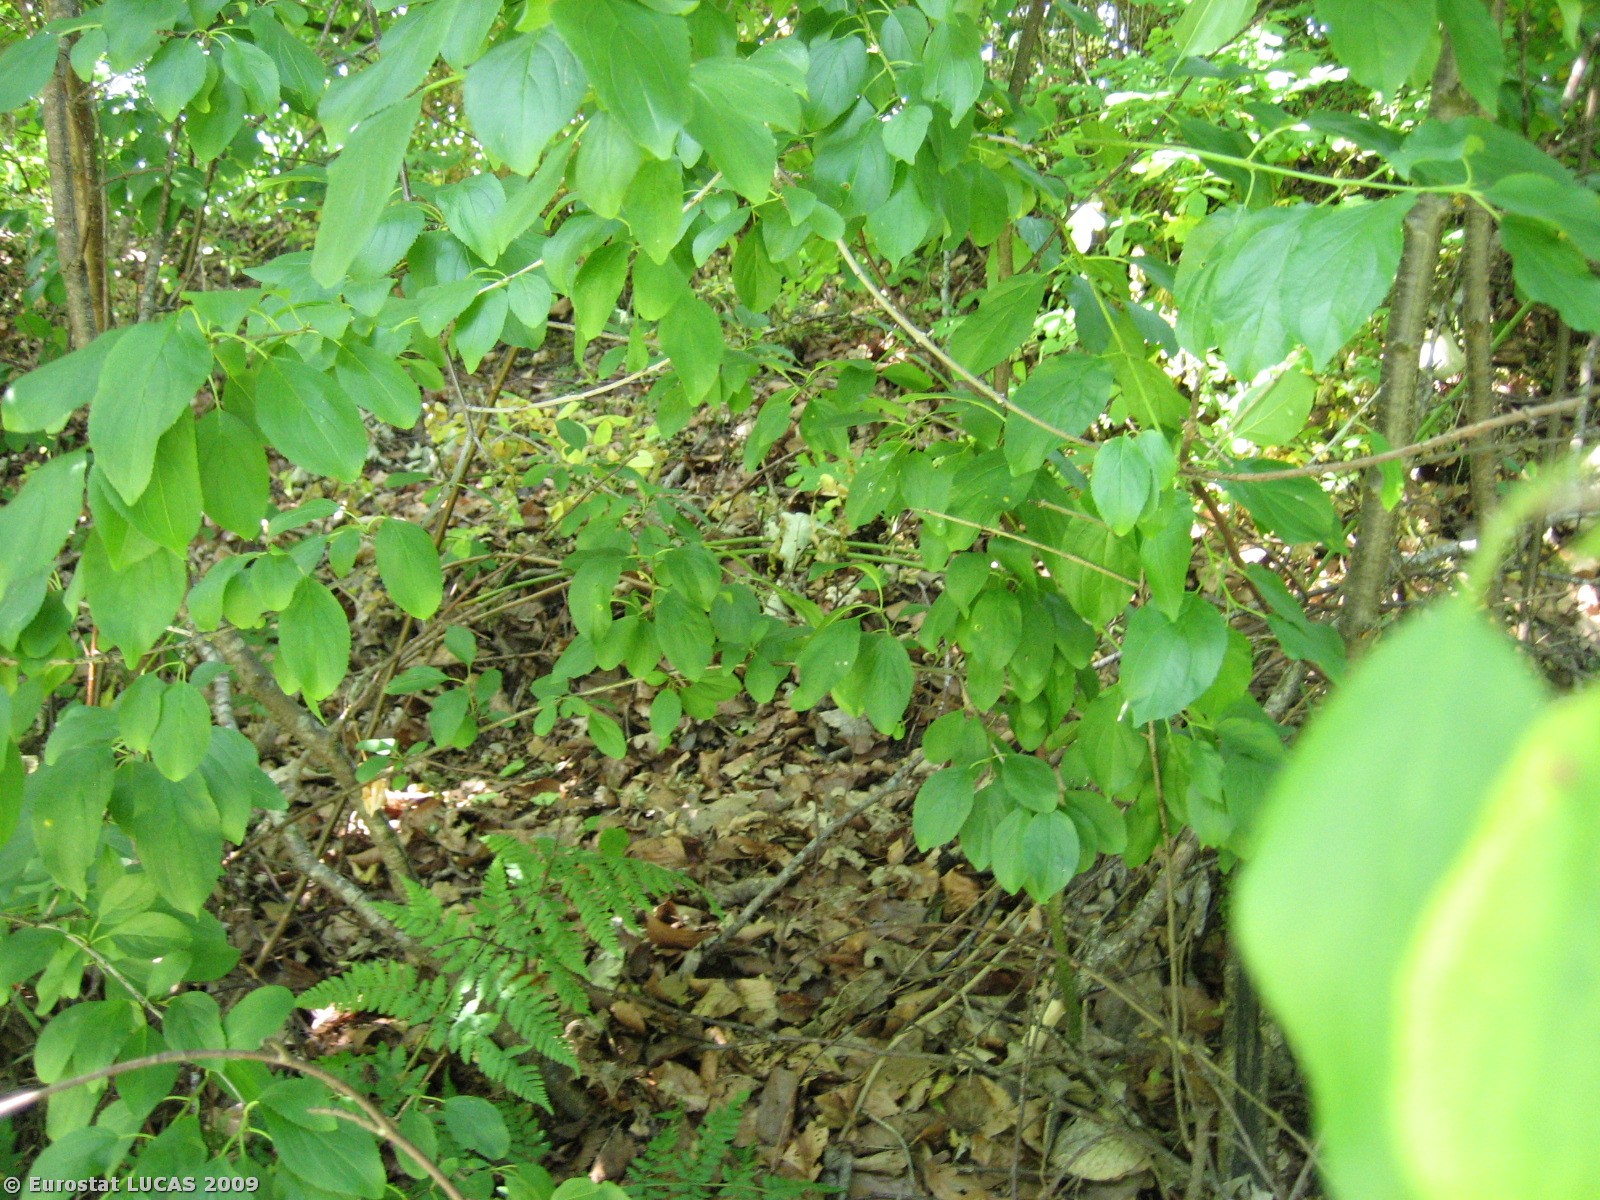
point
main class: Woodland
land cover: Broadleaved woodland
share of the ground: > 75 %
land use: Unused
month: July
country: DK
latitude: 55.6081
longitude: 8.9374
